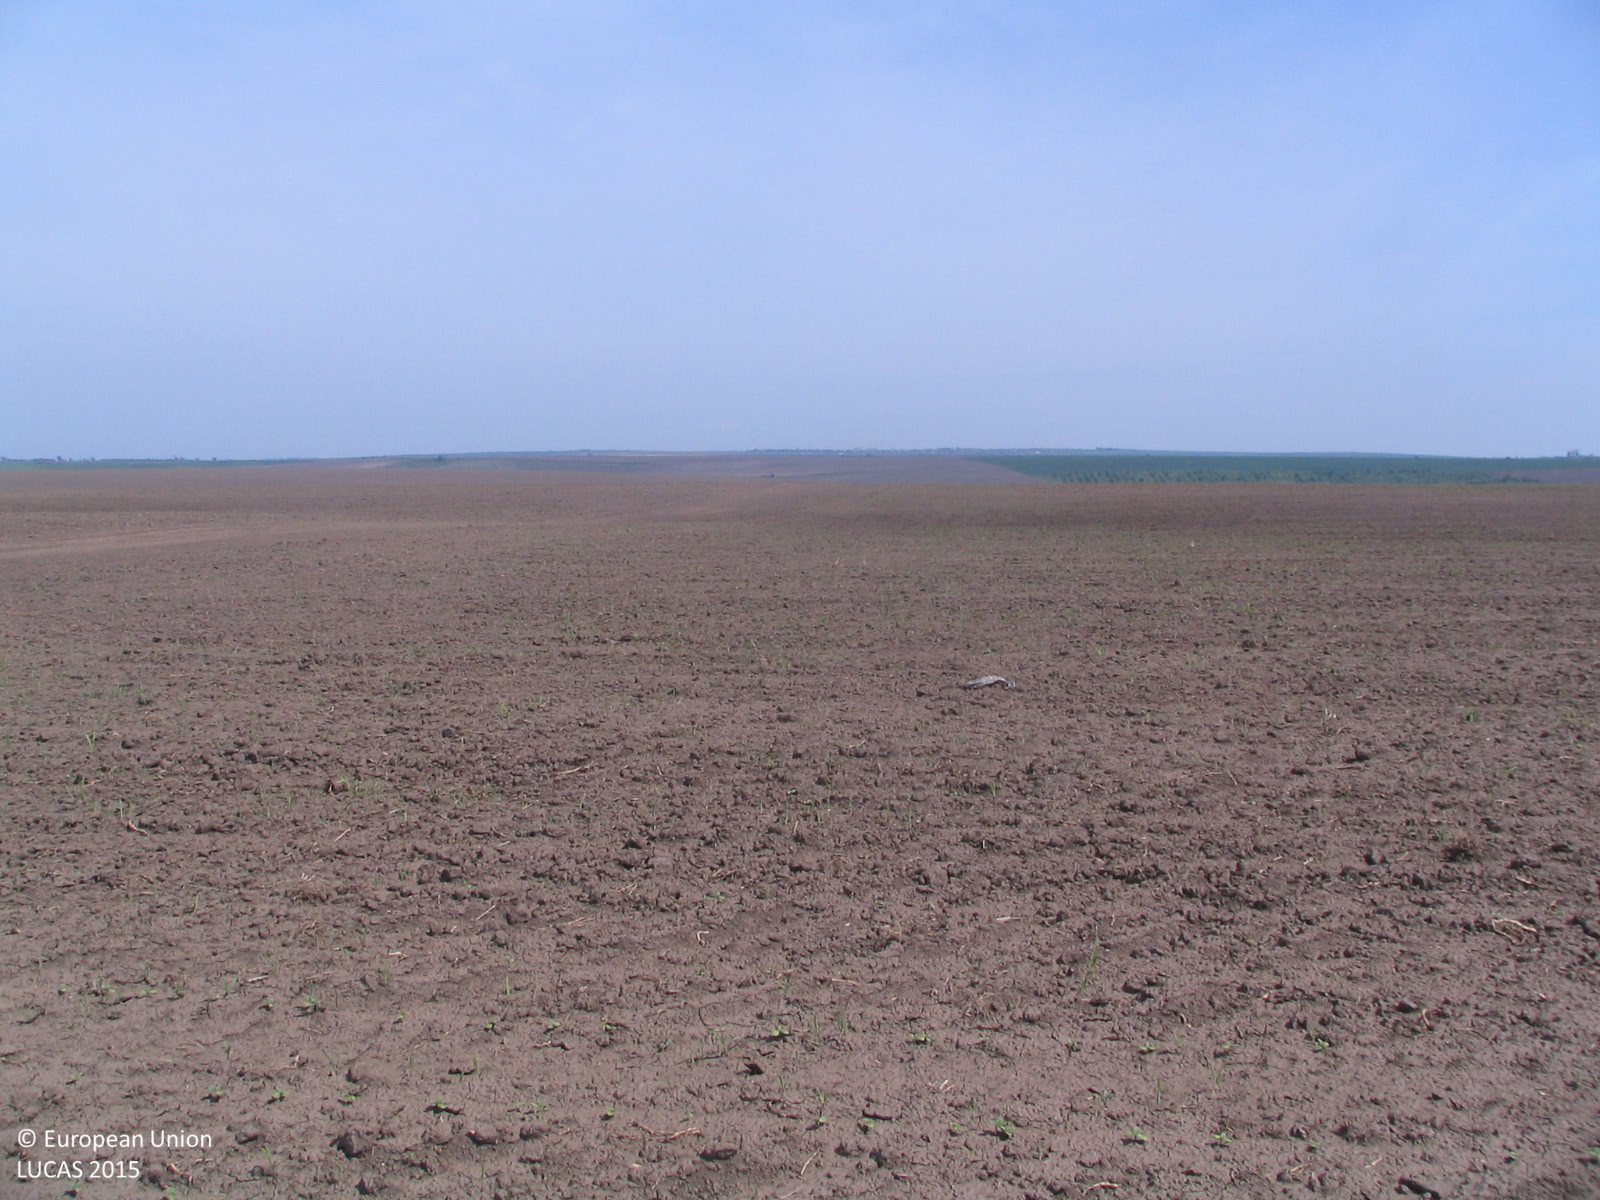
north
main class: Cropland
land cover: Sunflower
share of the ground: < 10 %
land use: Agriculture (excluding fallow land and kitchen gardens)
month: May
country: BG
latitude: 43.6440
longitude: 23.9251
